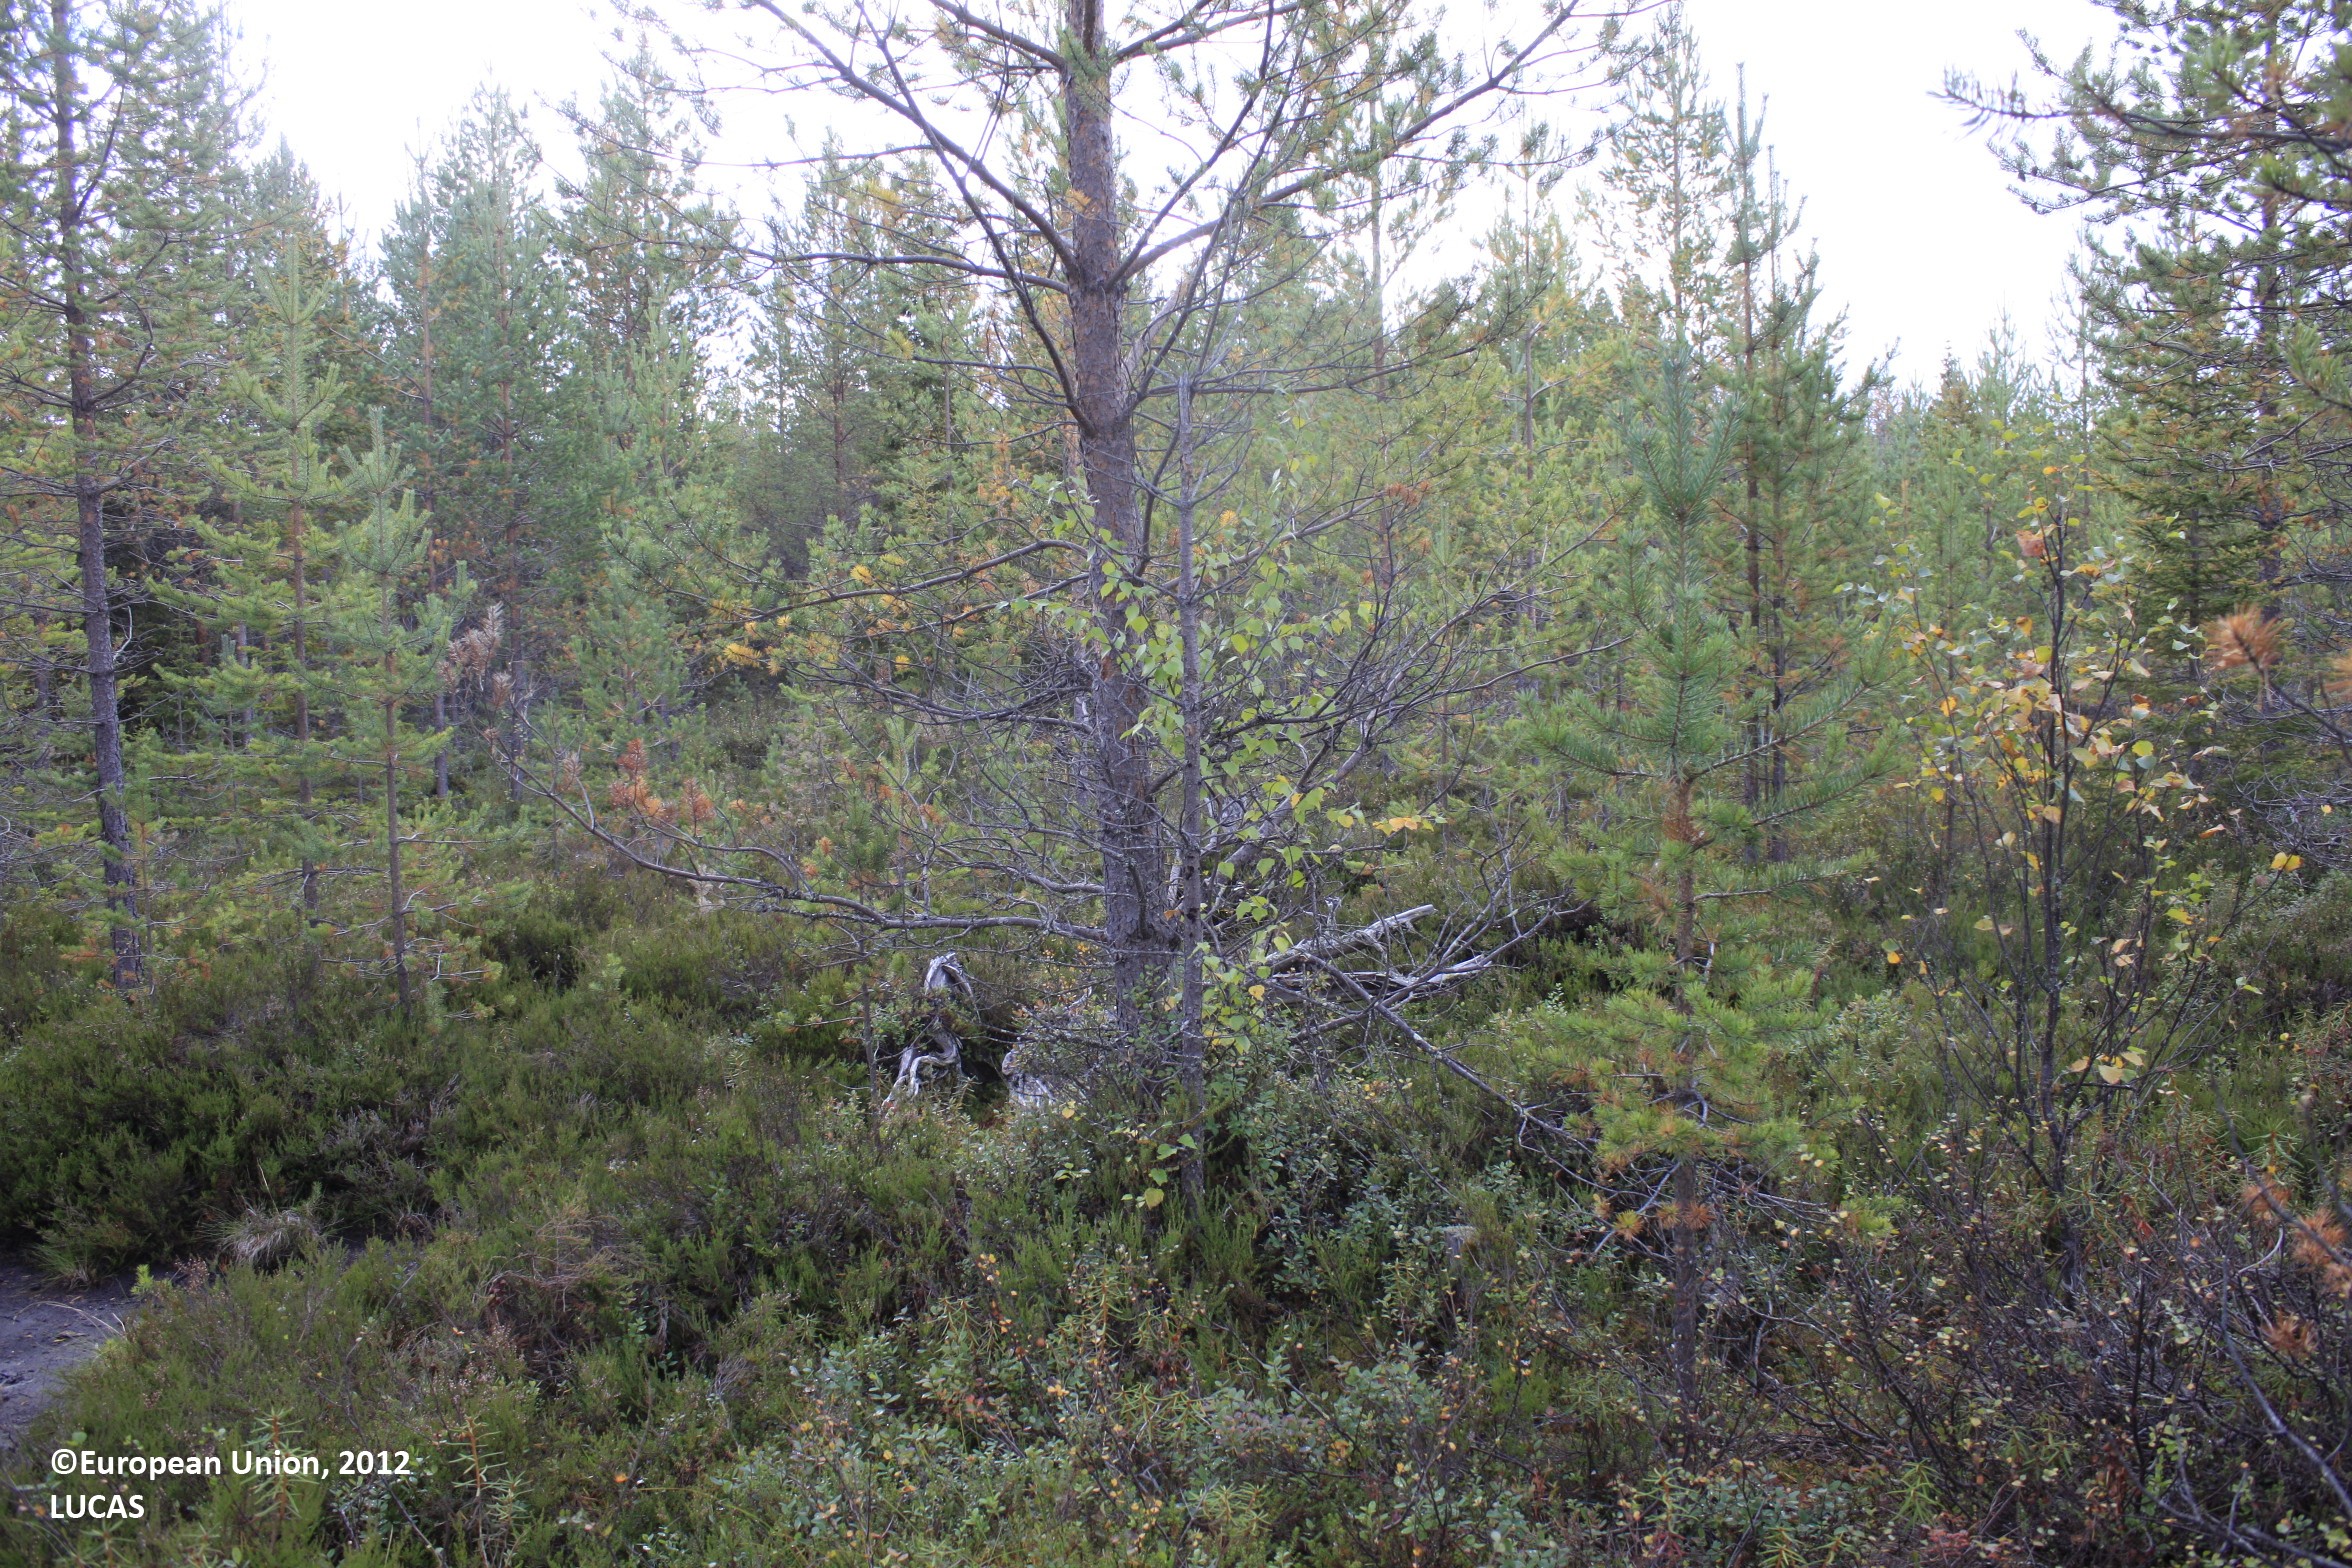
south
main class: Woodland
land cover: Pine dominated coniferous woodland
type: boreal forest
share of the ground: 25 - 50 %
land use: Forestry
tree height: > 5 m
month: September
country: FI
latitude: 65.6935
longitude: 27.0749
